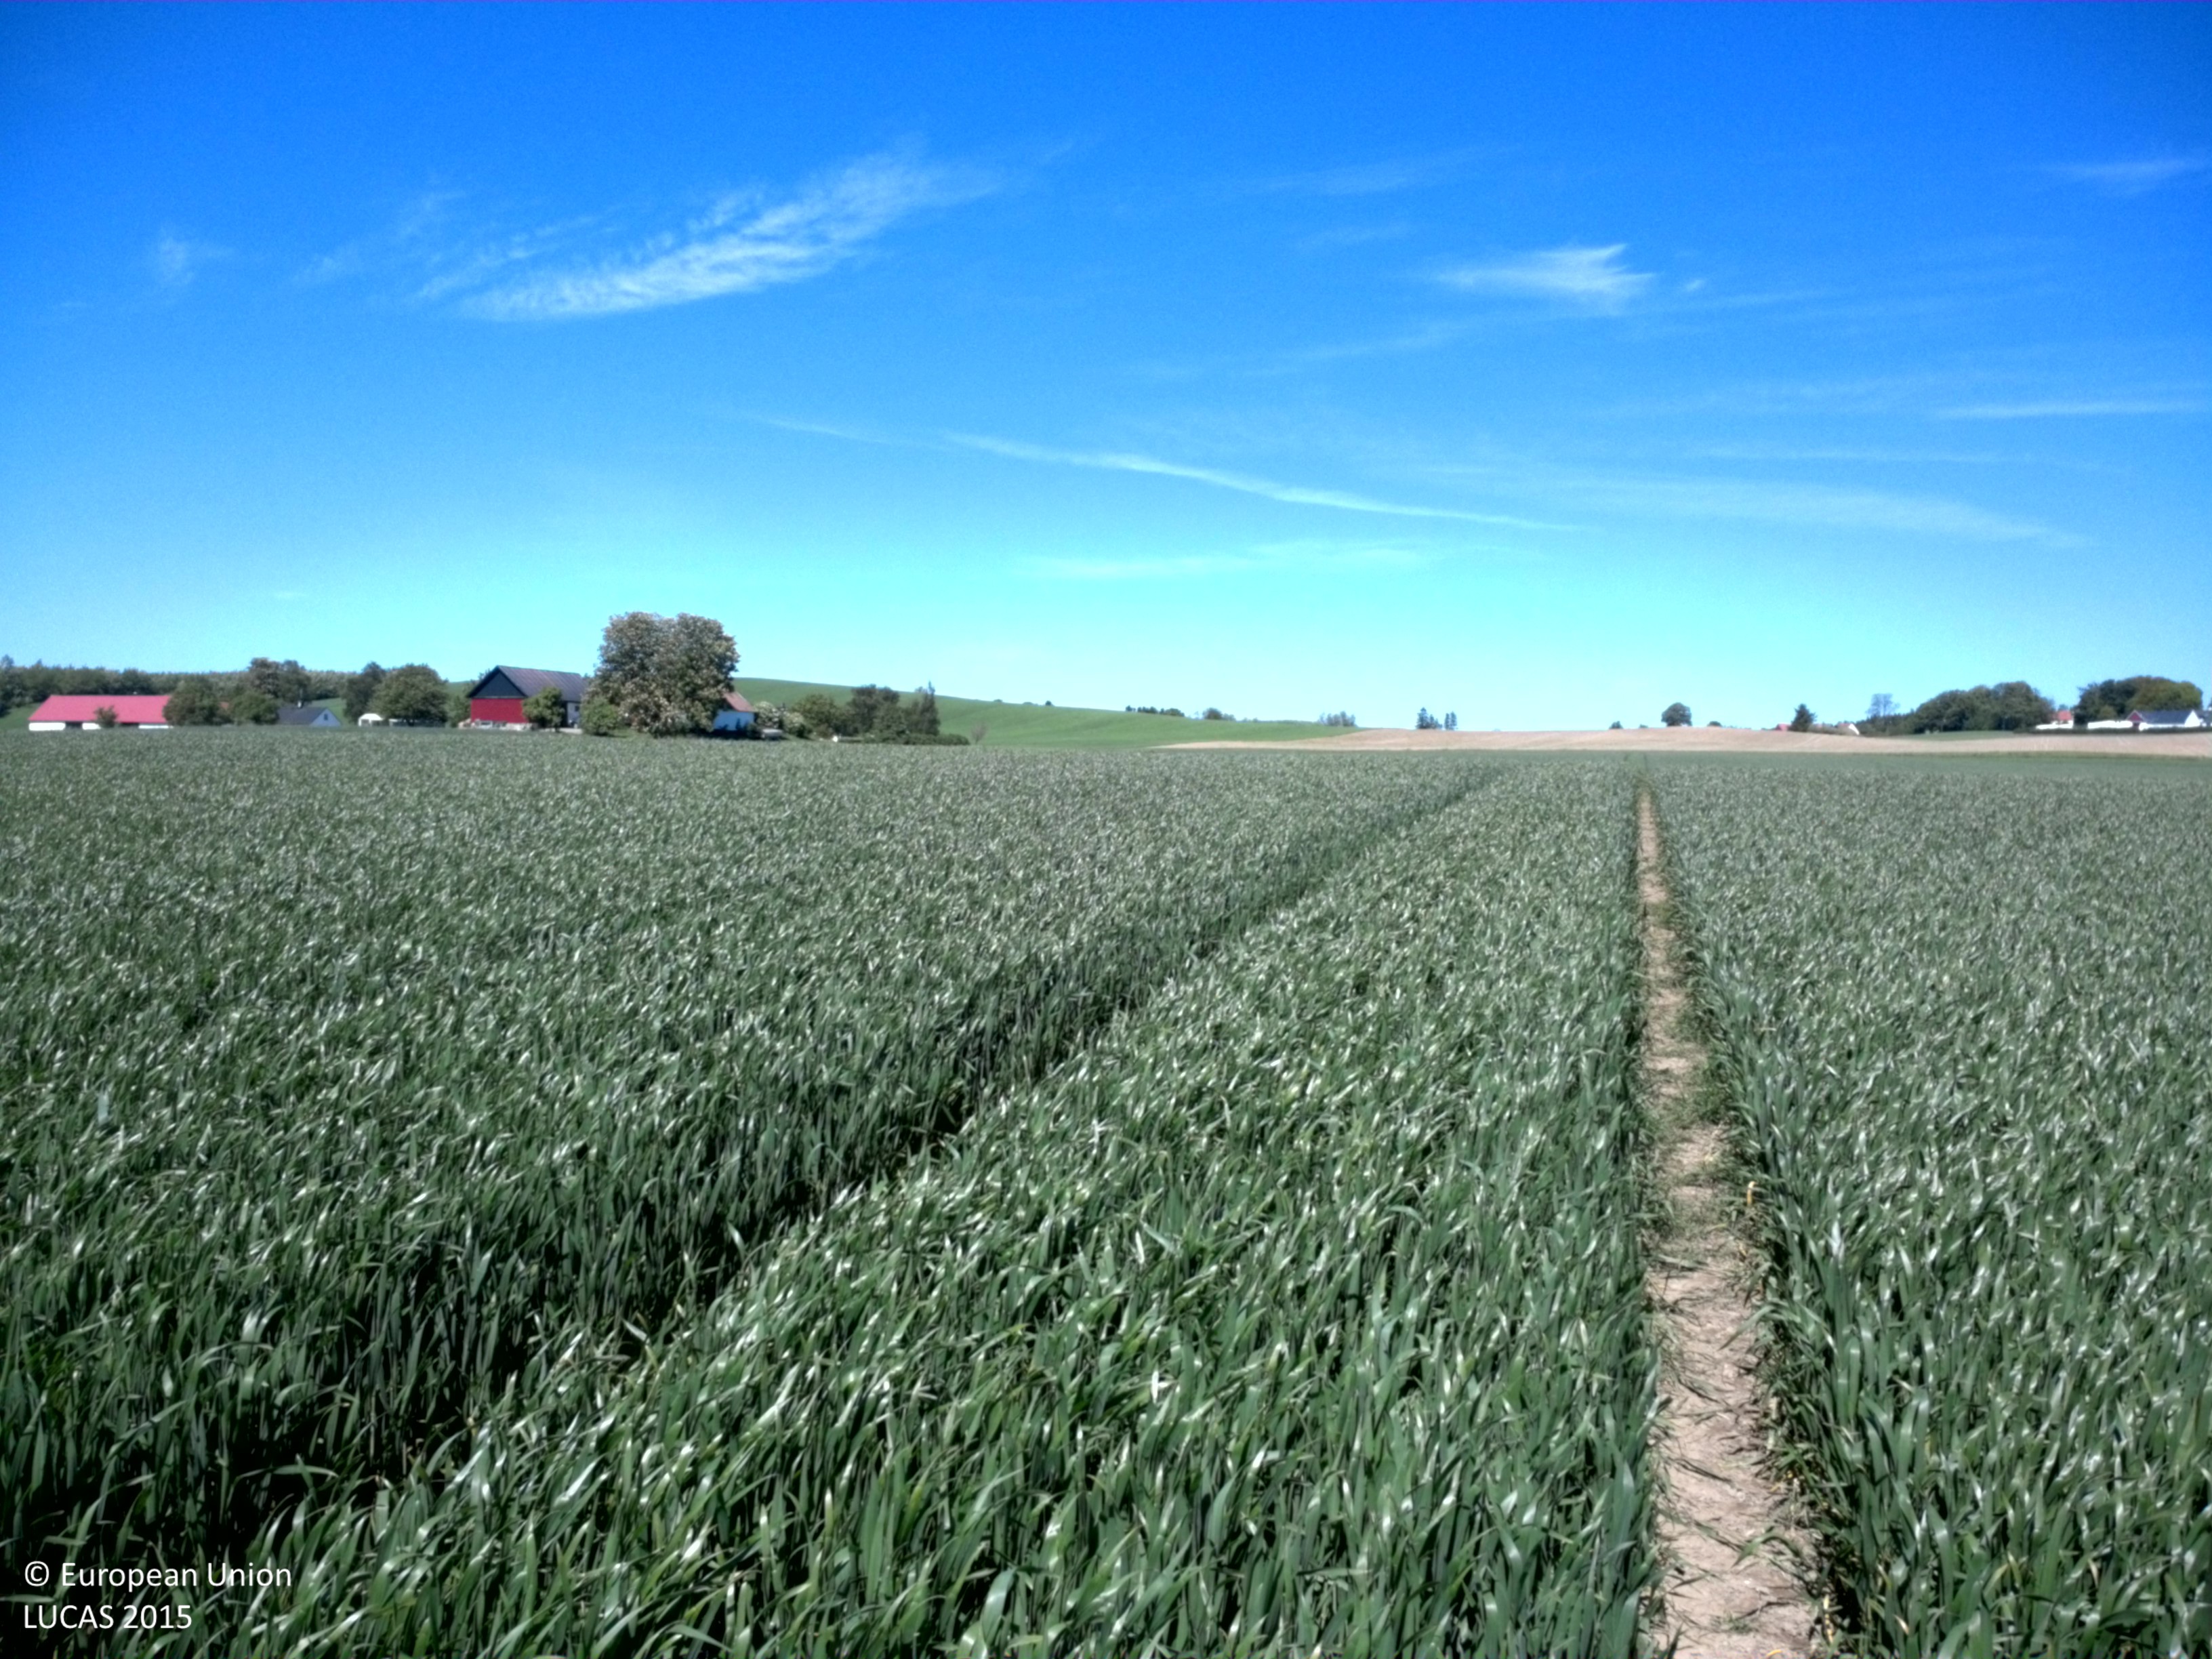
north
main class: Cropland
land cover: Common wheat
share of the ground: > 75 %
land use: Agriculture (excluding fallow land and kitchen gardens)
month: June
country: SE
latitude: 55.4871
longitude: 13.6857
